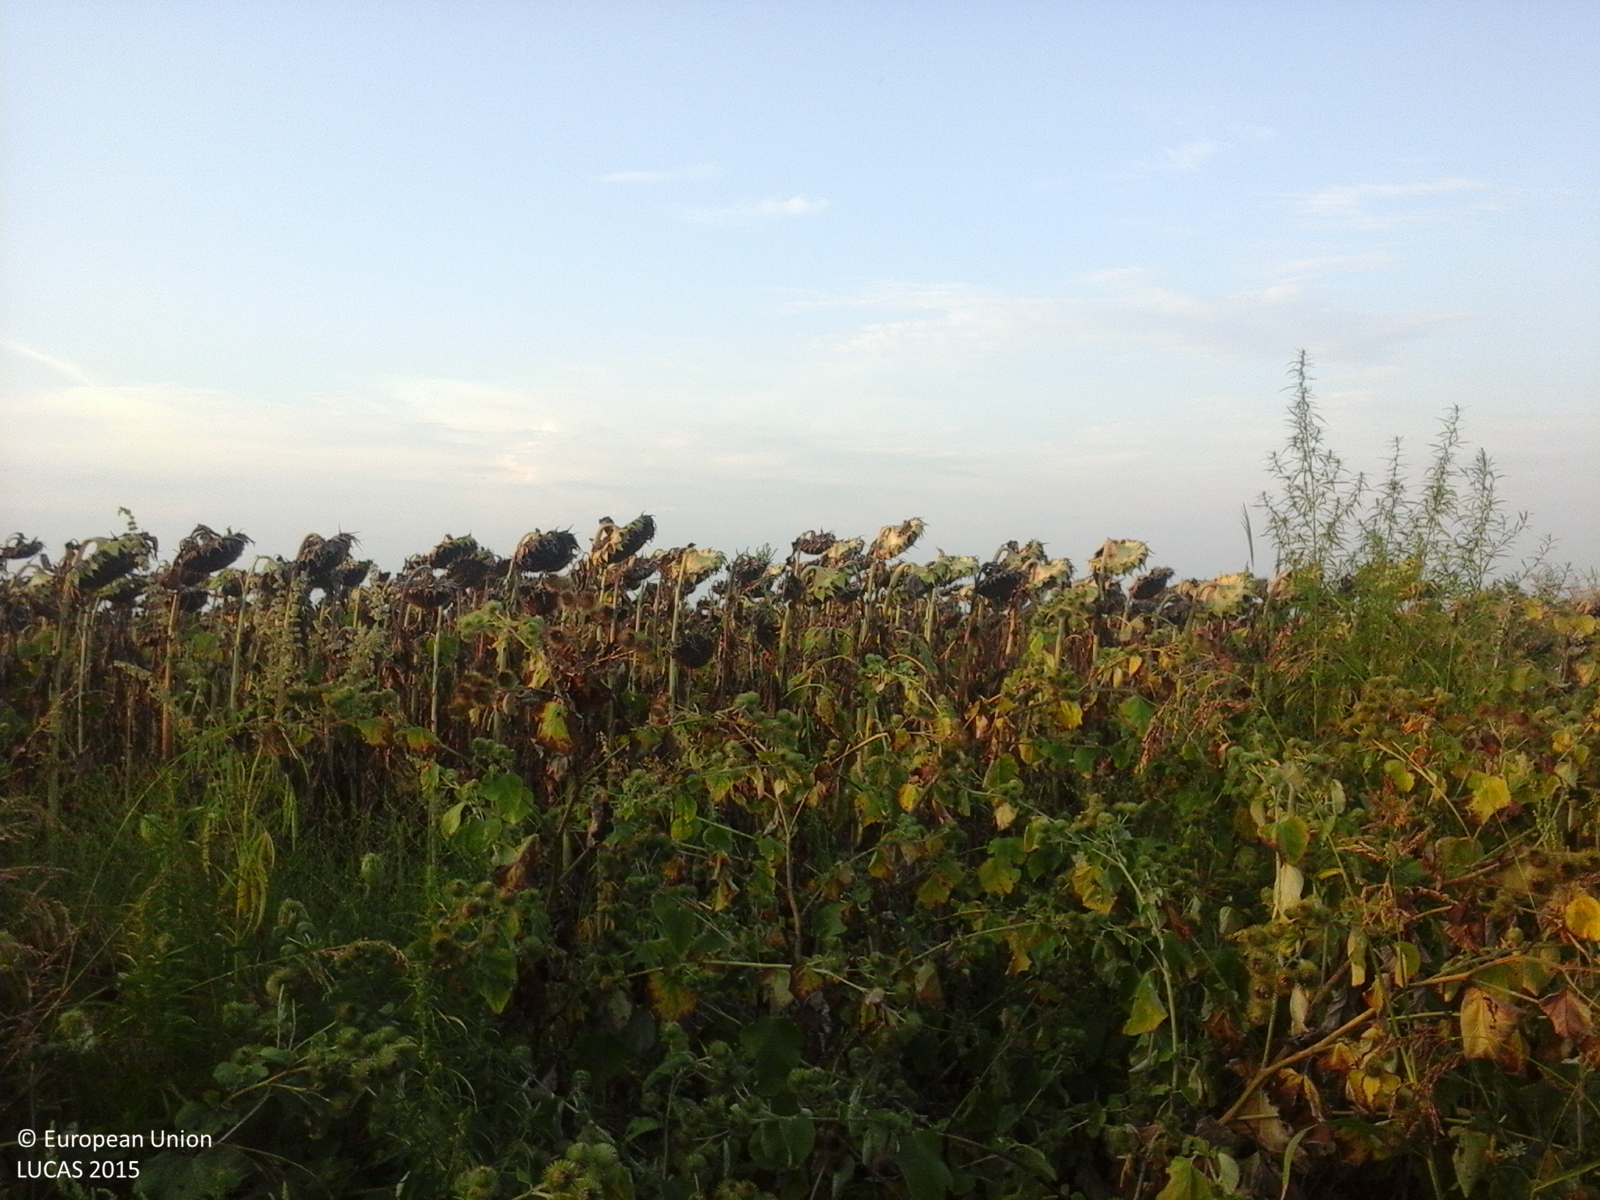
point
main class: Cropland
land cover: Sunflower
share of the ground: > 75 %
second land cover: Spontaneously vegetated surfaces
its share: 50 - 75 %
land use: Agriculture (excluding fallow land and kitchen gardens)
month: August
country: RO
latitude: 43.8900
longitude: 23.4538
